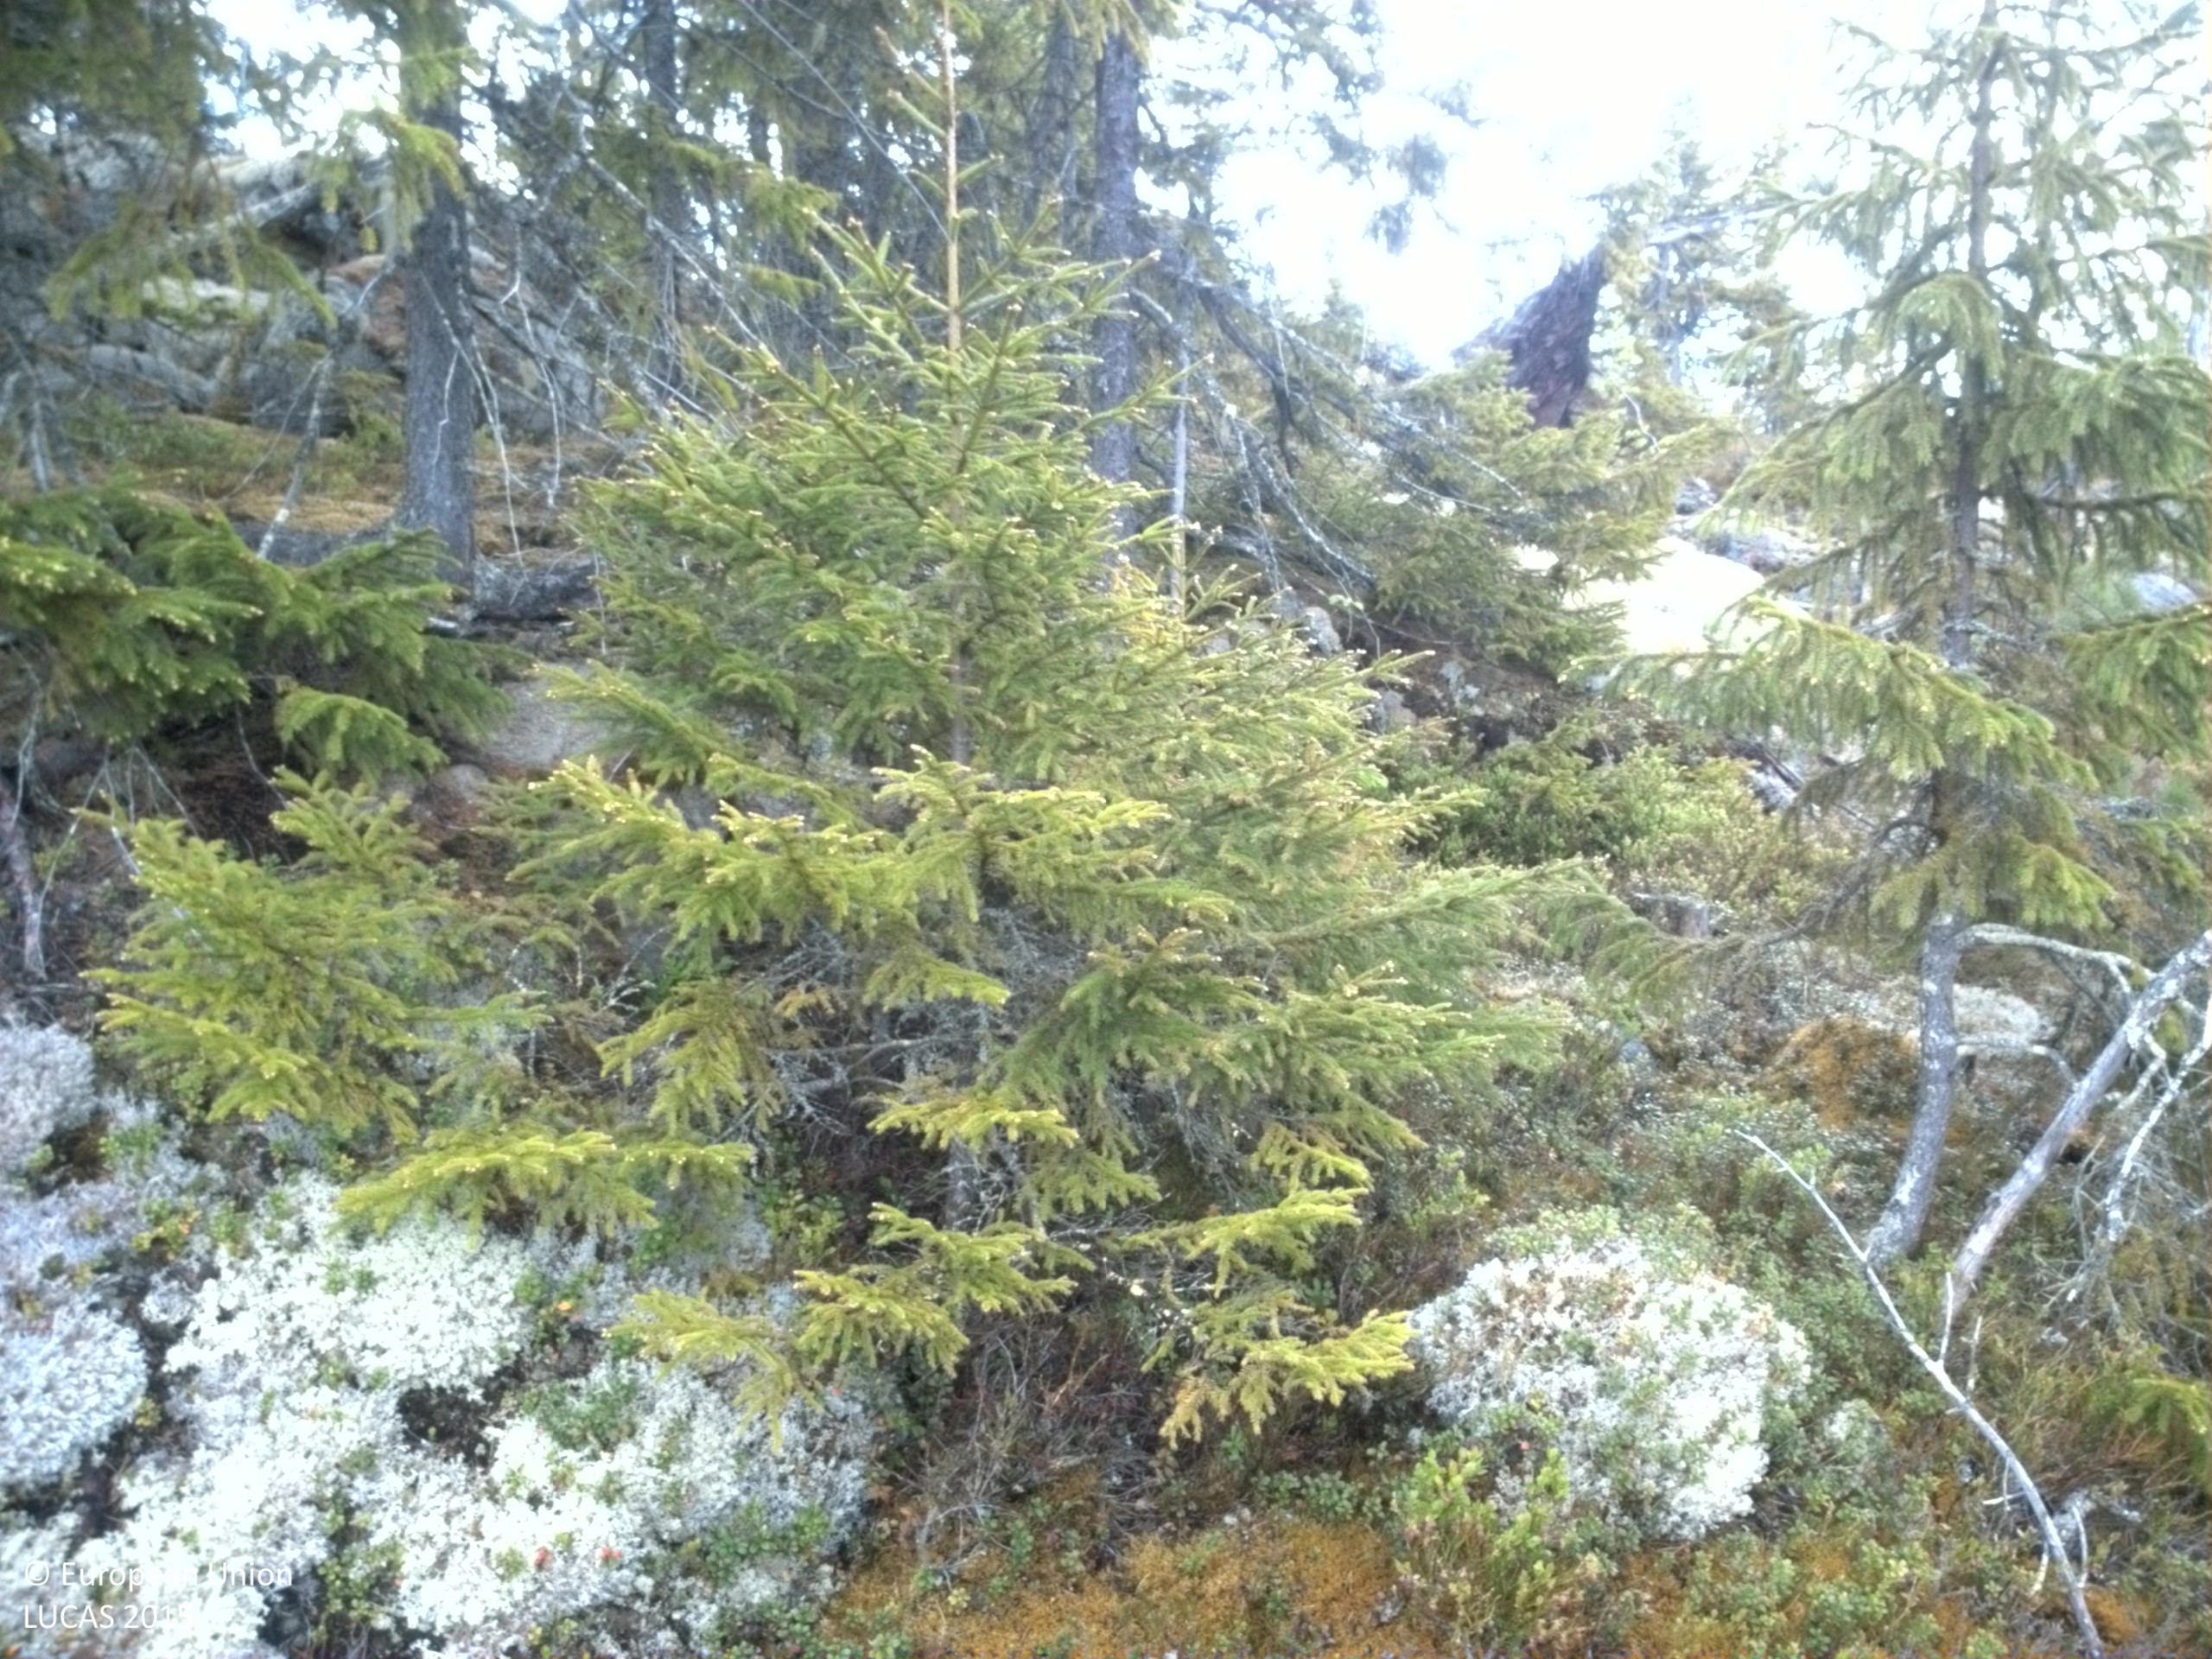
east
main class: Woodland
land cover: Pine dominated mixed woodland
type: boreal forest
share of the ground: 50 - 75 %
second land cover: Shrubland without tree cover
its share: 25 - 50 %
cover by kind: shrubs 40 %, coniferous forest trees 30 %, broadleaved forest trees 20 %, lichens and mosses 10 %
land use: Forestry
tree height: < 5 m
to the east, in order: Pine dominated mixed woodland; Shrubland without tree cover; Pine dominated coniferous woodland
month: June
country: SE
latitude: 63.0871
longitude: 17.6801
